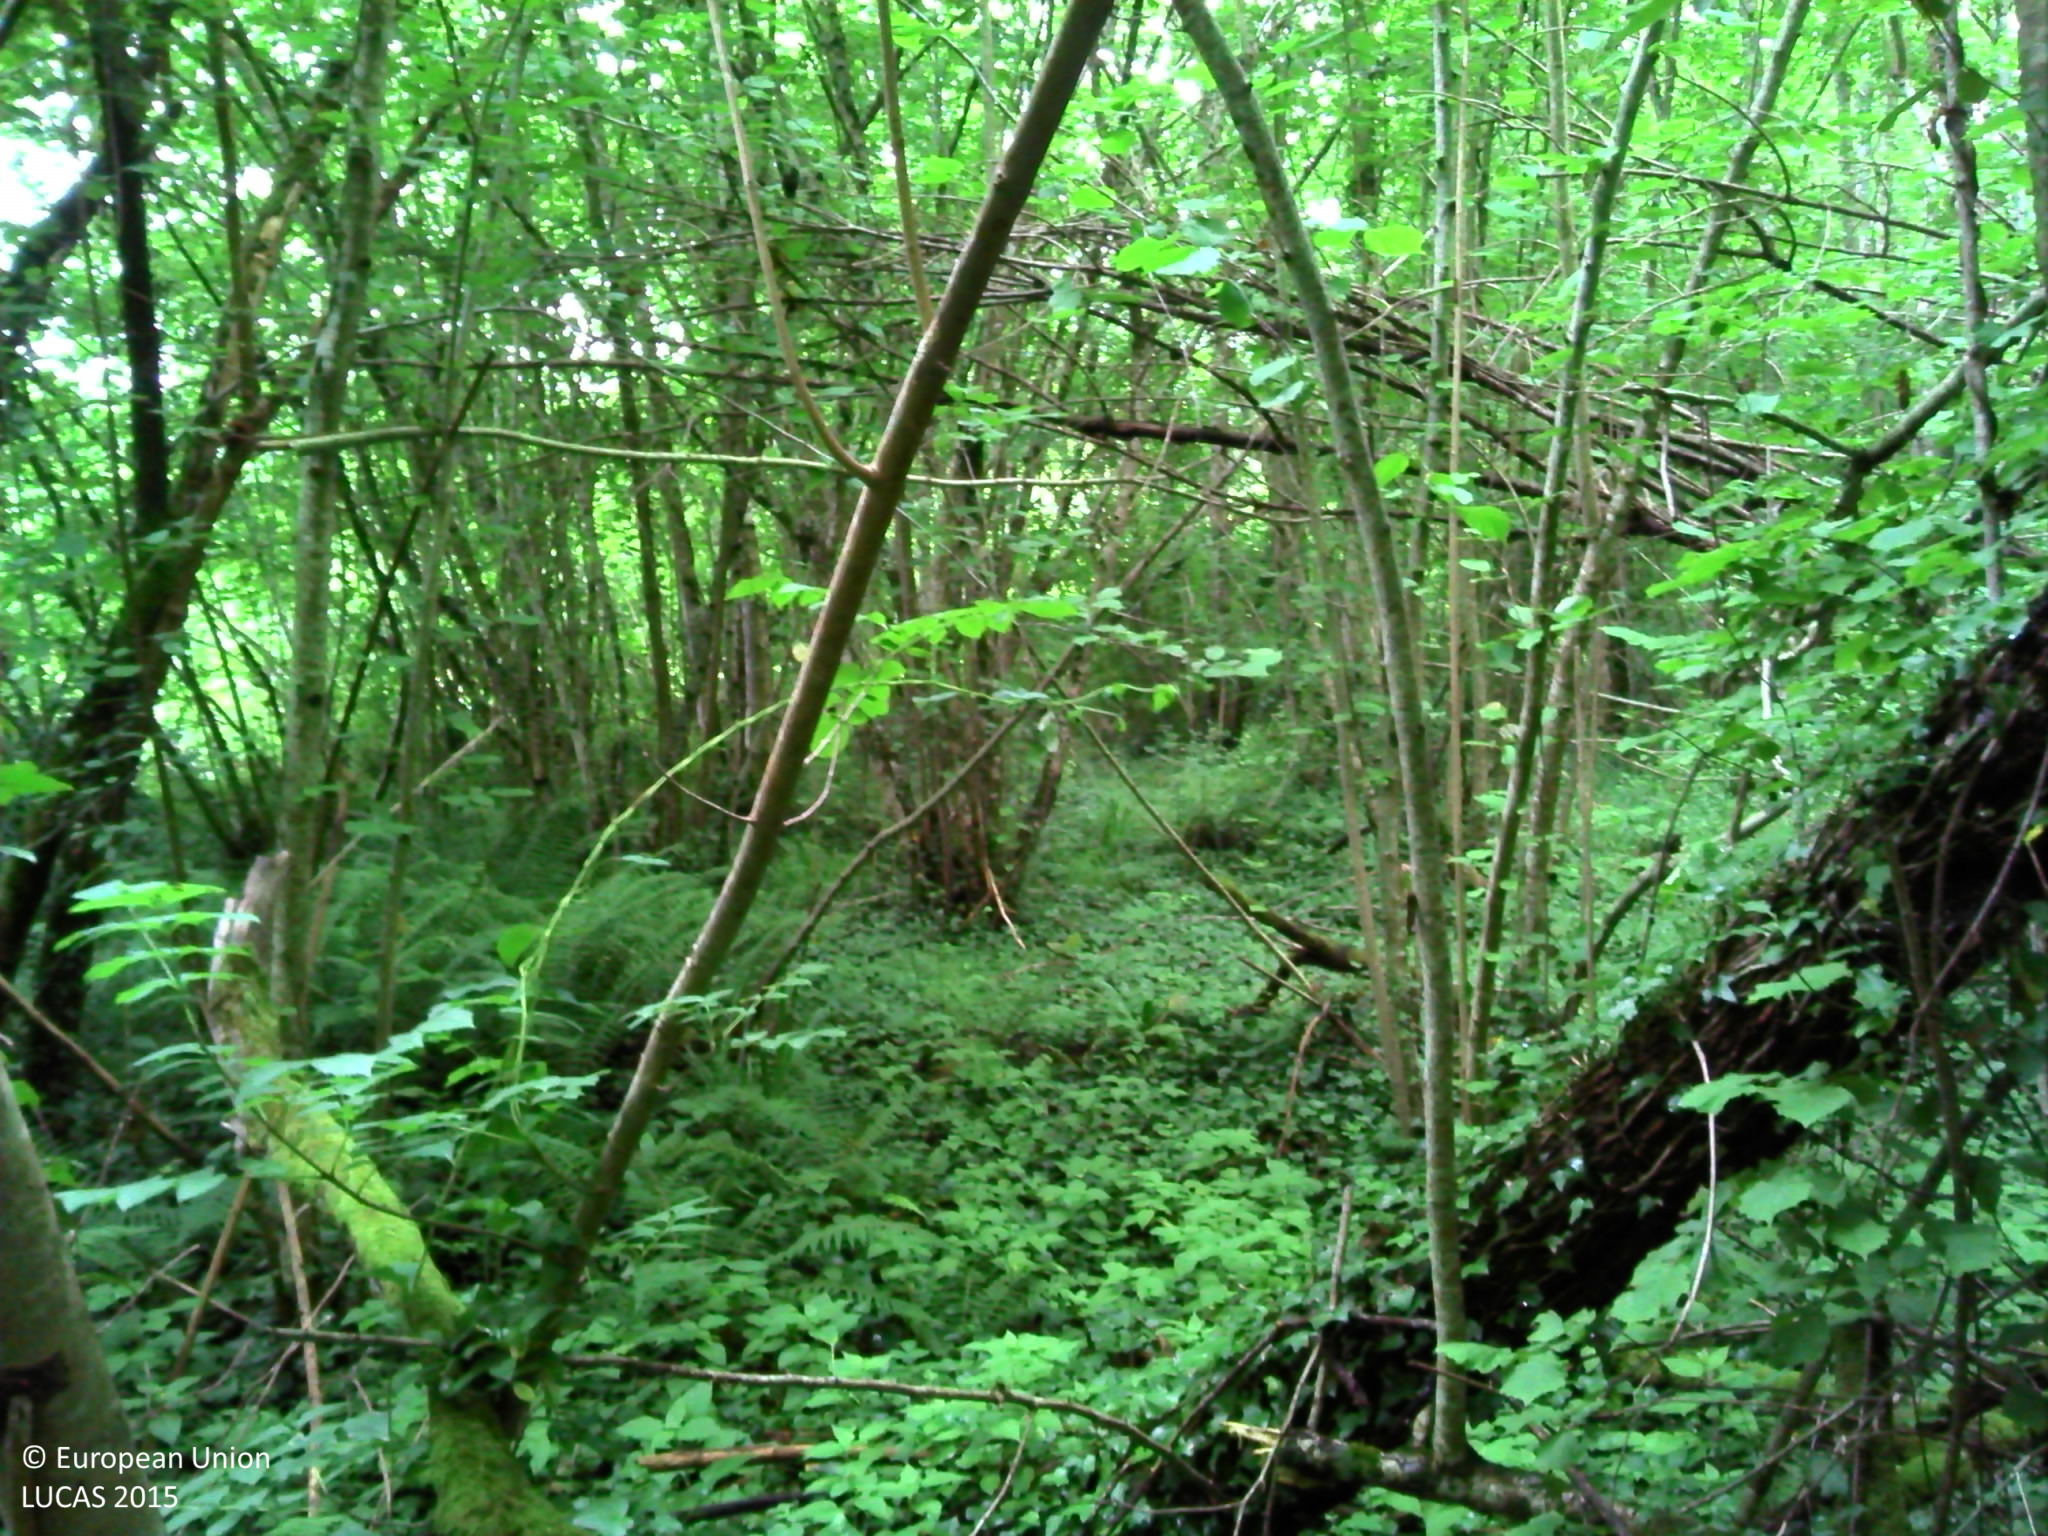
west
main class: Woodland
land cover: Broadleaved woodland
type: floodplain forest
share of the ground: > 75 %
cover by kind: broadleaved forest trees 80 %, herbaceous plants 20 %
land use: Forestry
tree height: > 5 m
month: June
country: FR
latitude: 43.2178
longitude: -0.3094
